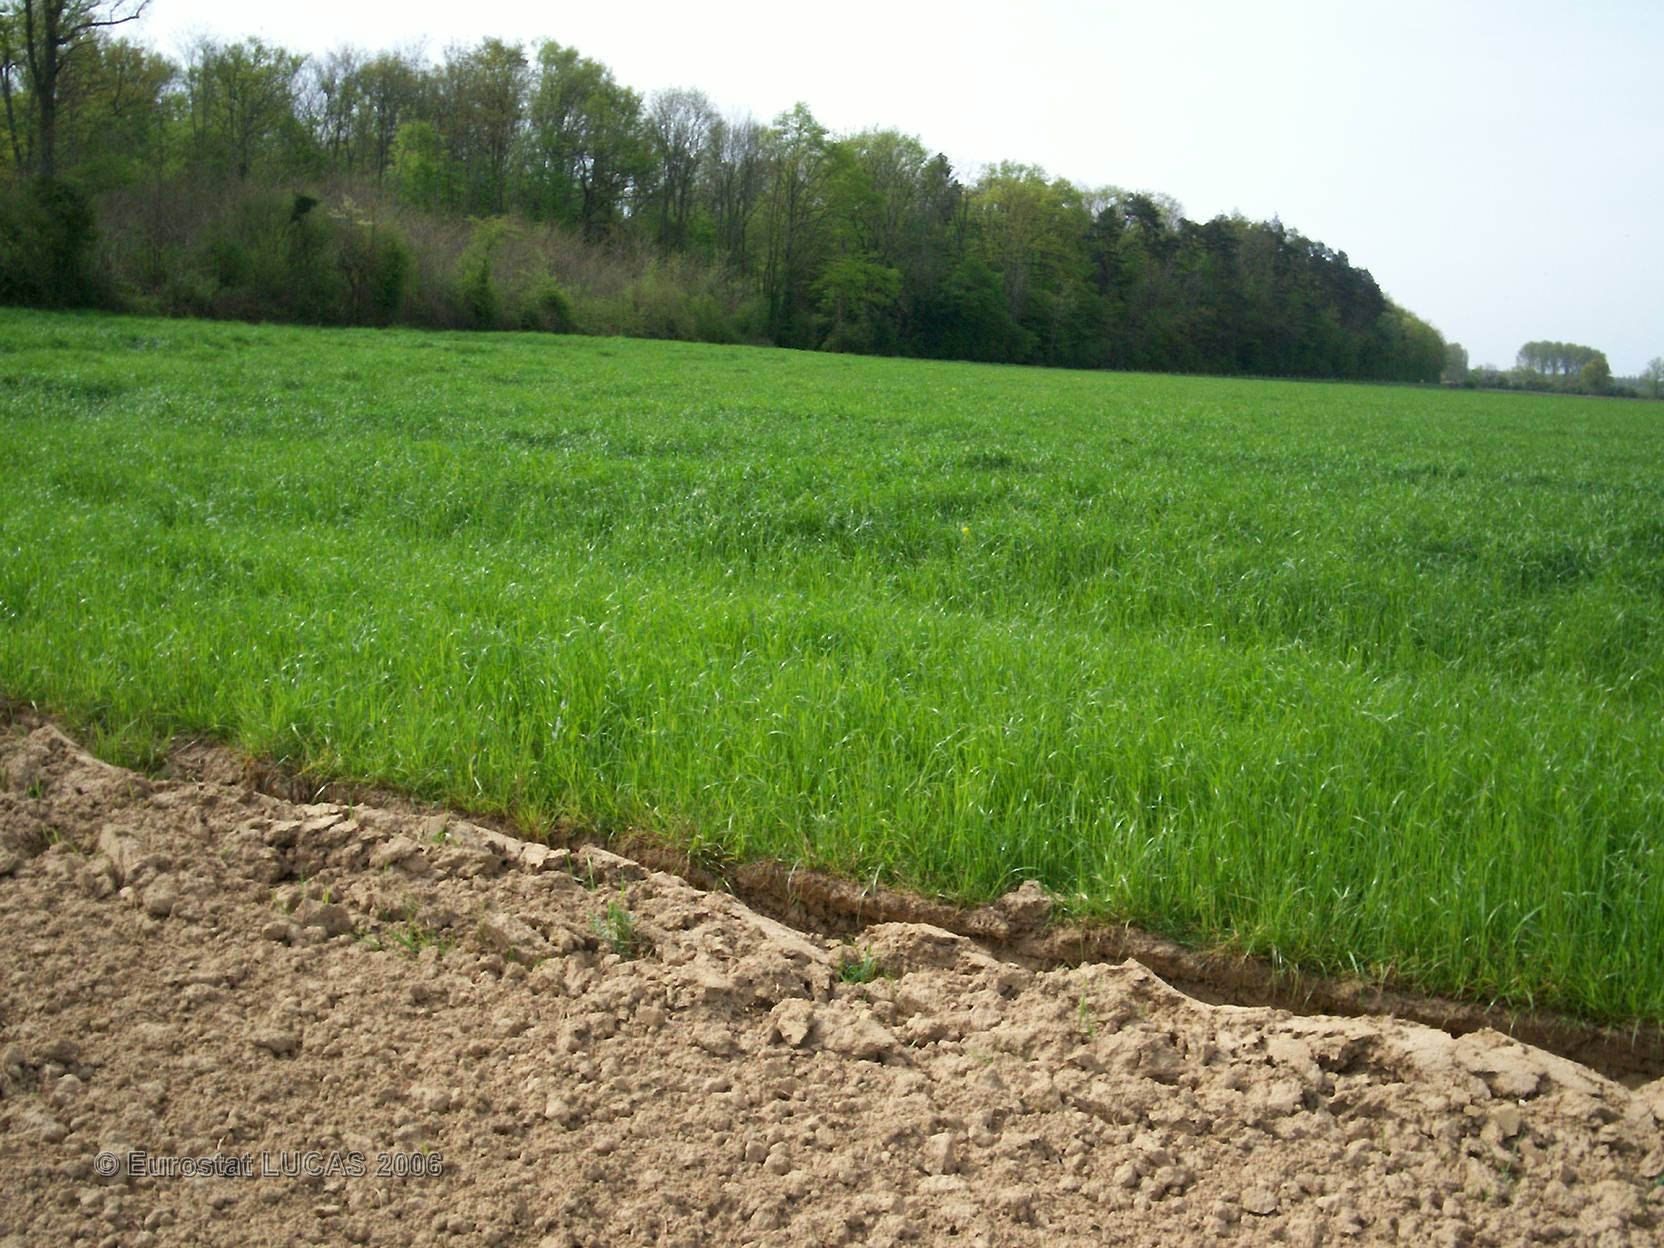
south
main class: Cropland
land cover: Other leguminous and mixtures for fodder
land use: Agriculture (excluding fallow land and kitchen gardens)
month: May
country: FR
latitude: 48.0436
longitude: 4.0275
